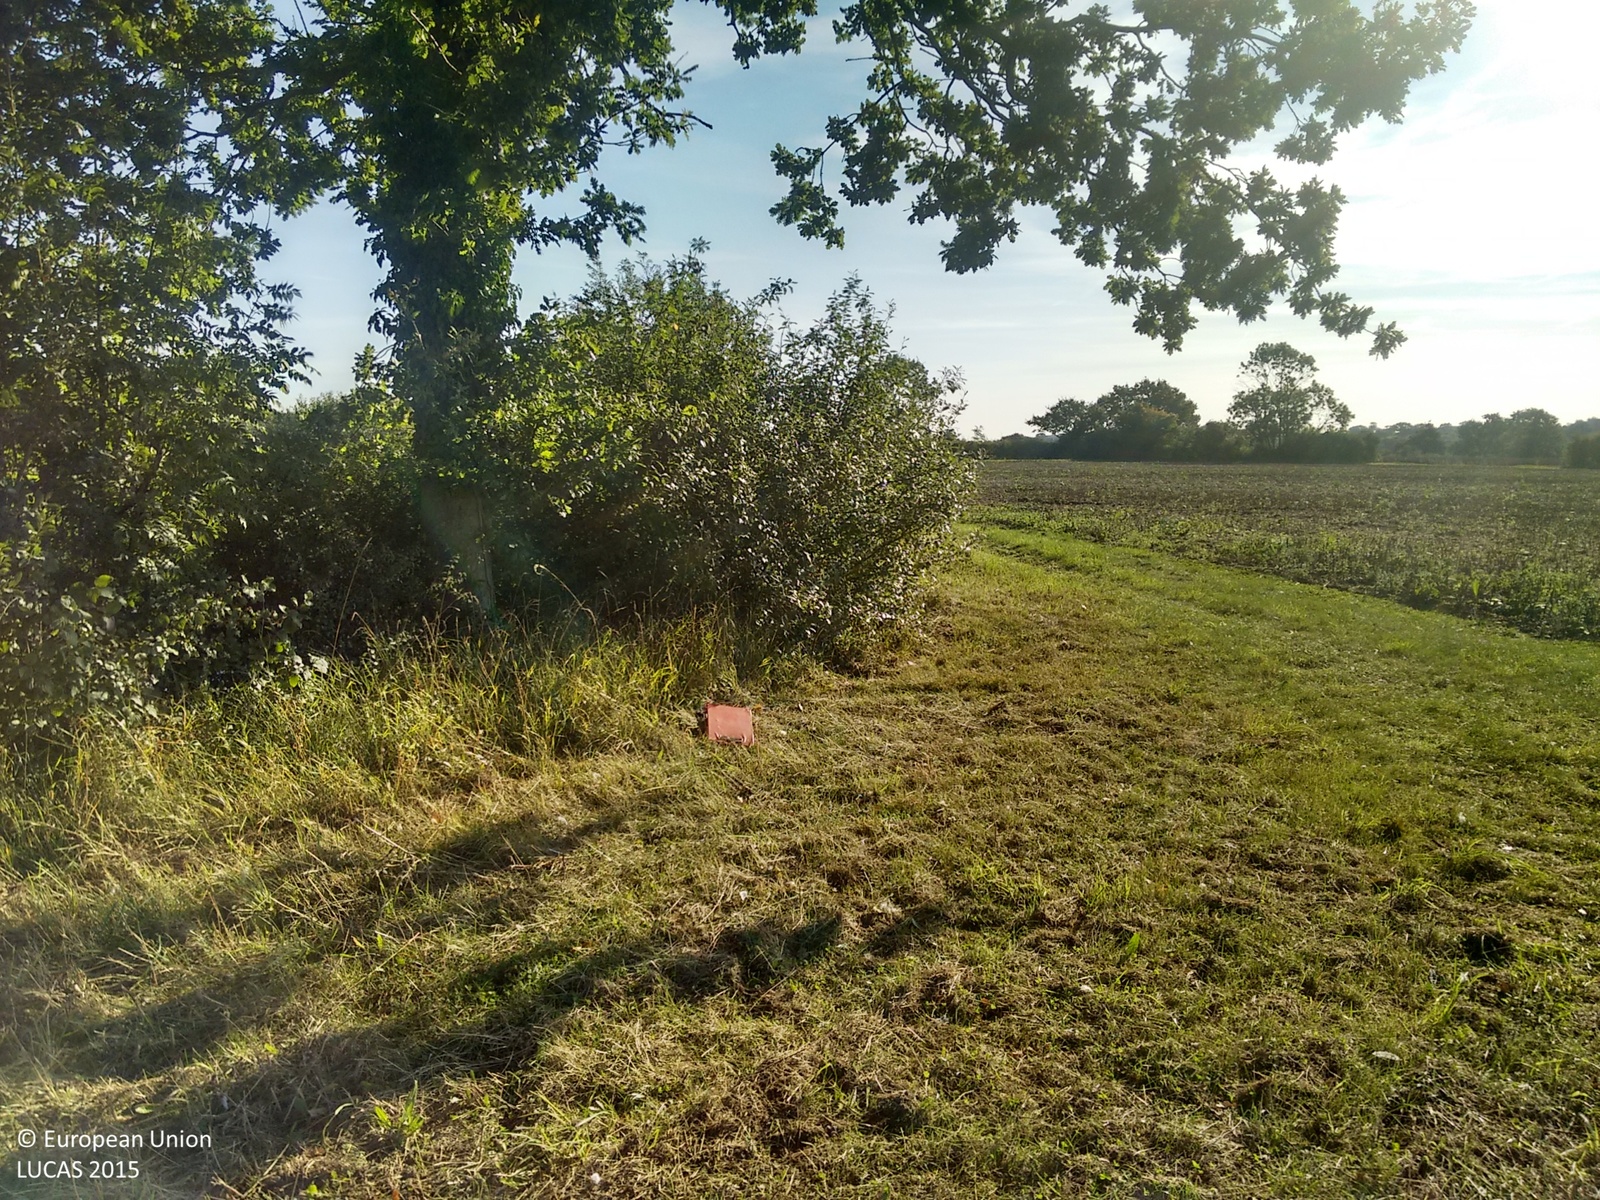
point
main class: Grassland
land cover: Grassland without tree/shrub cover
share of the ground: > 75 %
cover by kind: herbaceous plants 80 %, unconsolidated bare surface 20 %
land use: Agriculture (excluding fallow land and kitchen gardens)
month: September
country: GB
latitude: 52.2467
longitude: 1.4119
